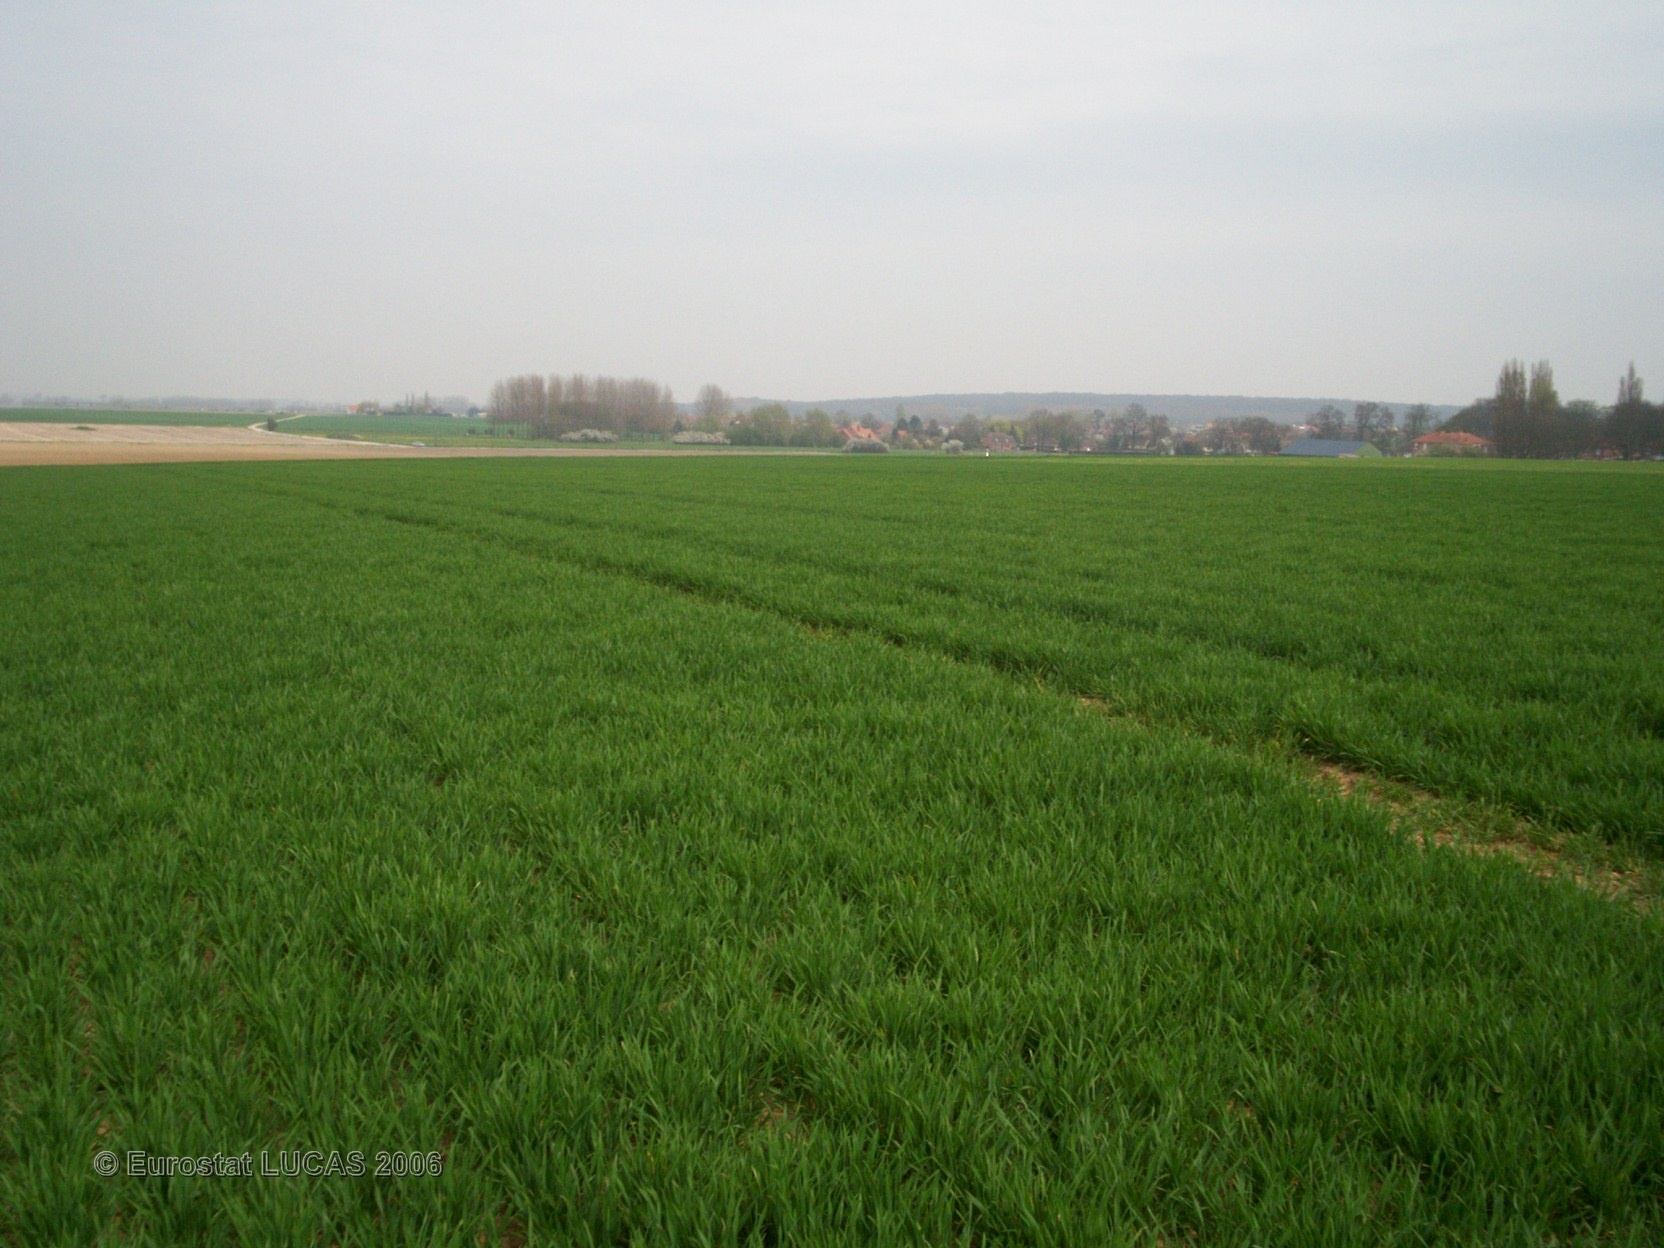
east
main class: Cropland
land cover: Common wheat
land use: Agriculture (excluding fallow land and kitchen gardens)
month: April
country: FR
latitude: 50.5328
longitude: 2.4959
